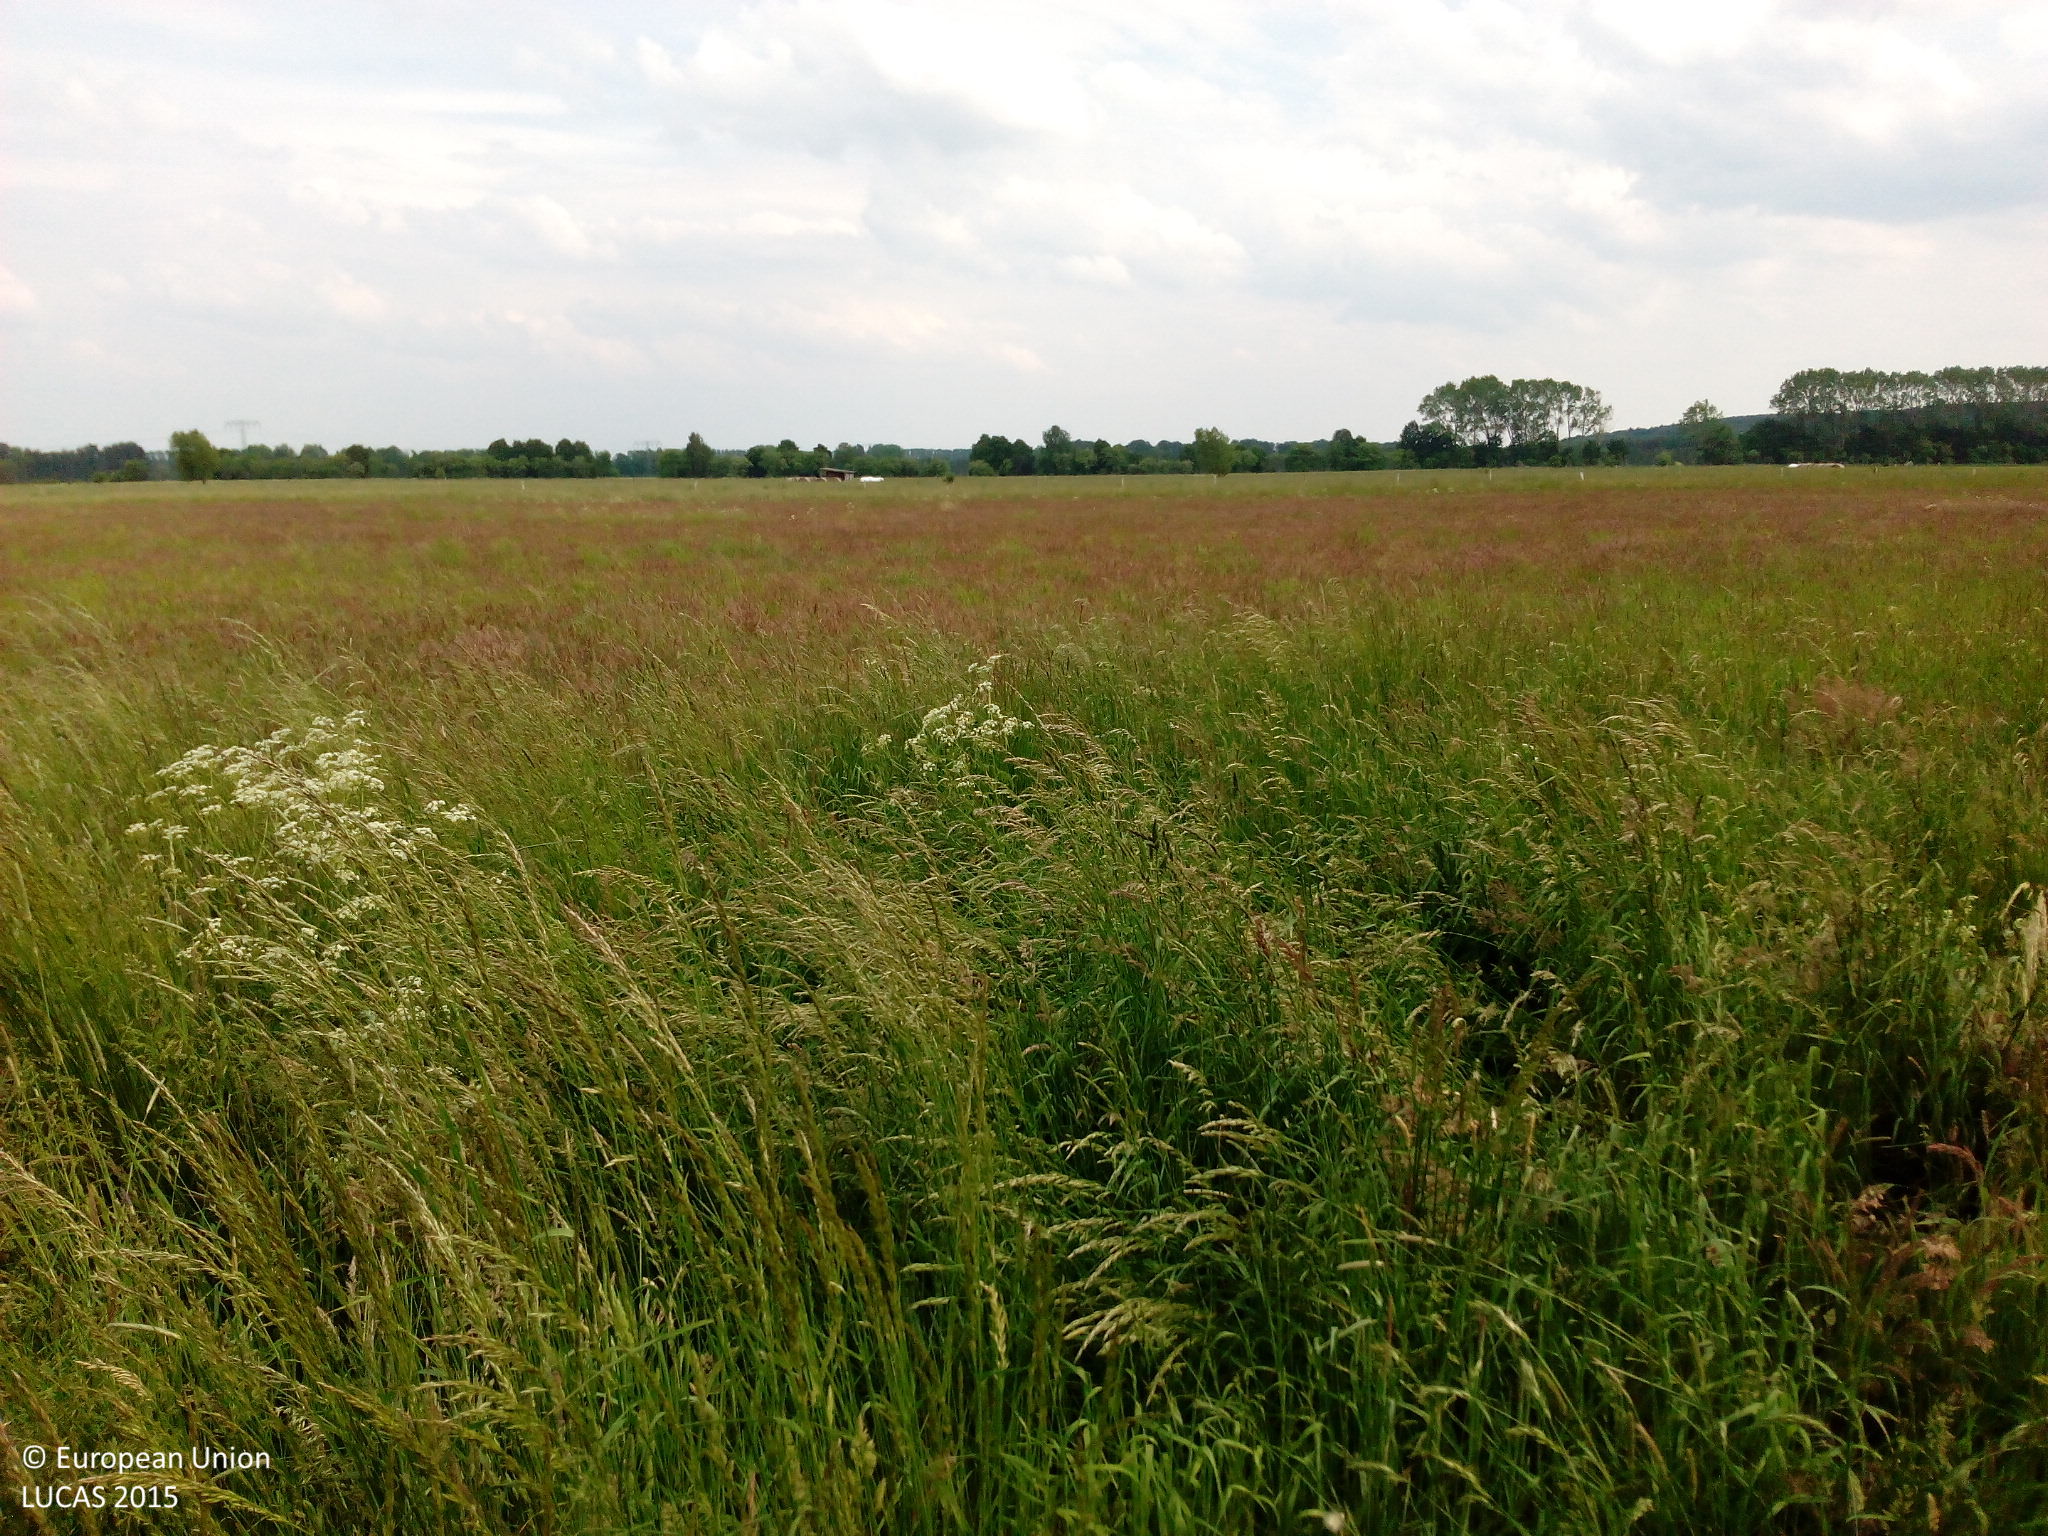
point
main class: Grassland
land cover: Grassland without tree/shrub cover
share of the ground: > 75 %
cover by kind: herbaceous plants 100 %
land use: Agriculture (excluding fallow land and kitchen gardens)
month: May
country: DE
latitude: 52.2413
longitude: 12.5918
